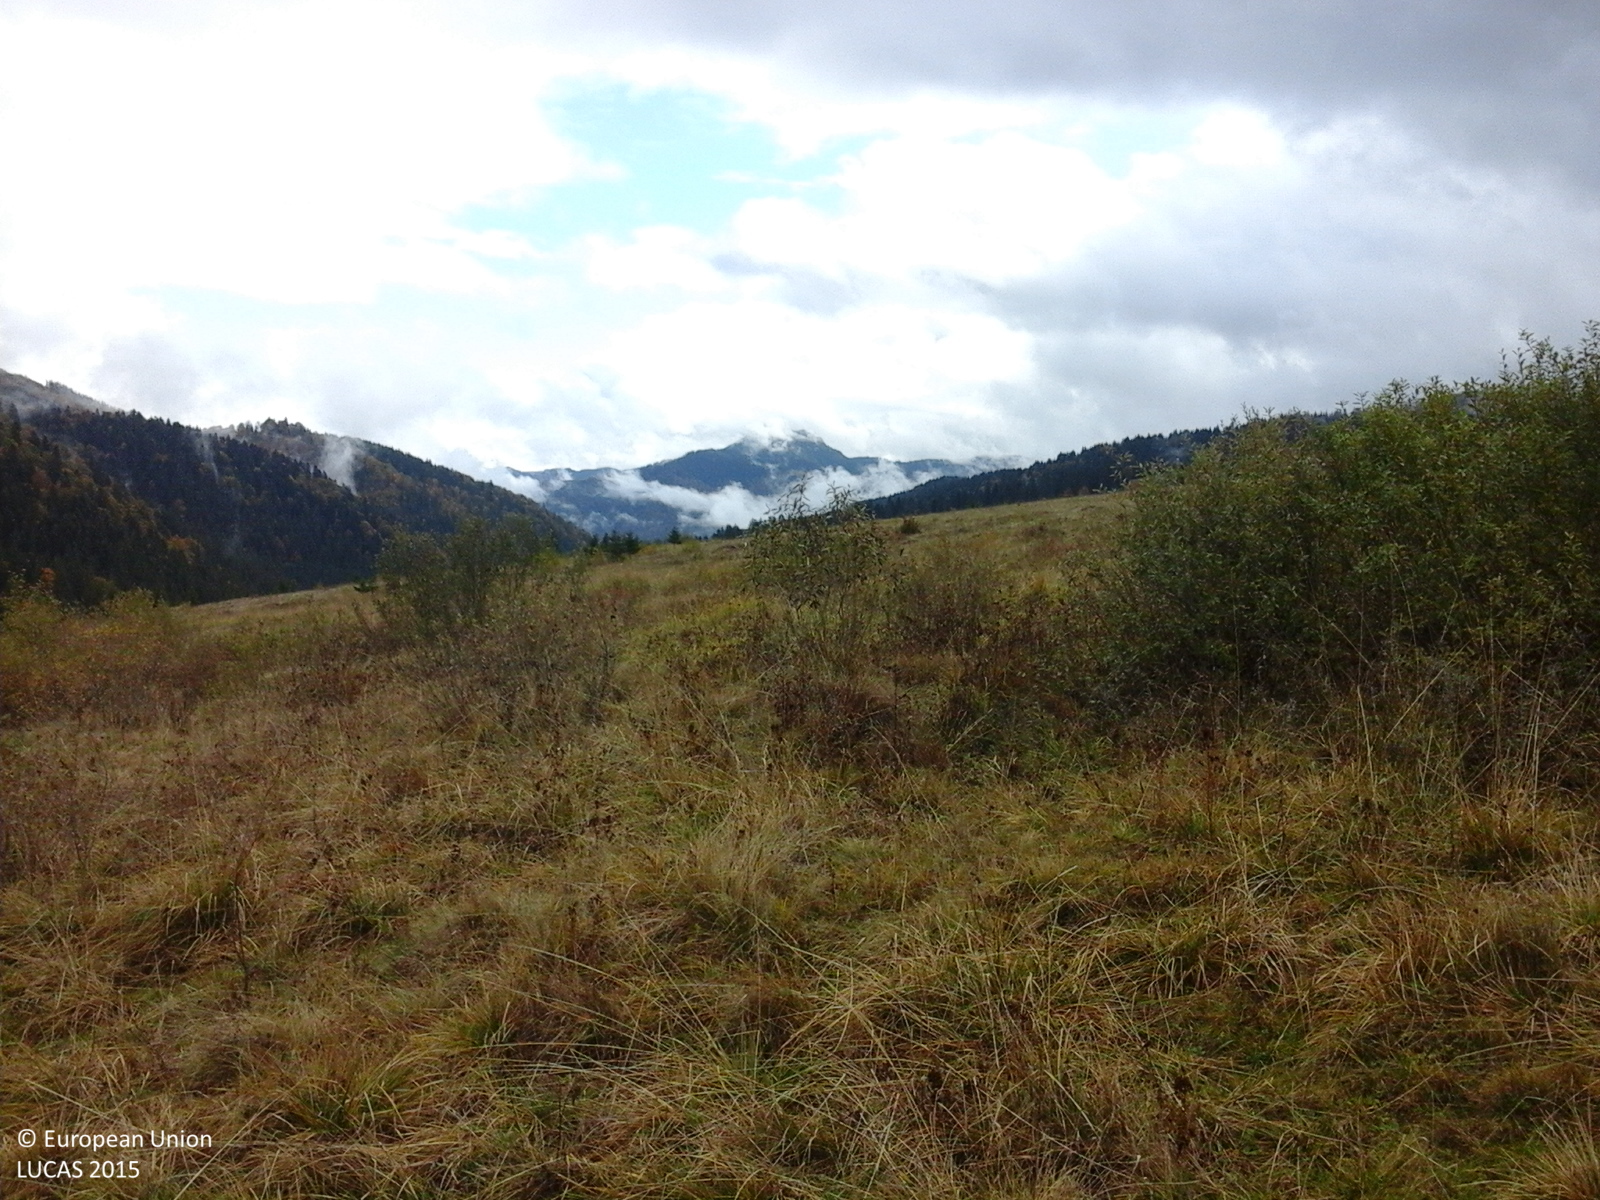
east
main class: Grassland
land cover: Grassland without tree/shrub cover
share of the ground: > 75 %
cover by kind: herbaceous plants 100 %
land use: Agriculture (excluding fallow land and kitchen gardens)
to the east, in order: Grassland without tree/shrub cover; Grassland with sparse tree/shrub cover; Grassland without tree/shrub cover; Grassland with sparse tree/shrub cover
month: October
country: RO
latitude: 46.8648
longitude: 25.6066
